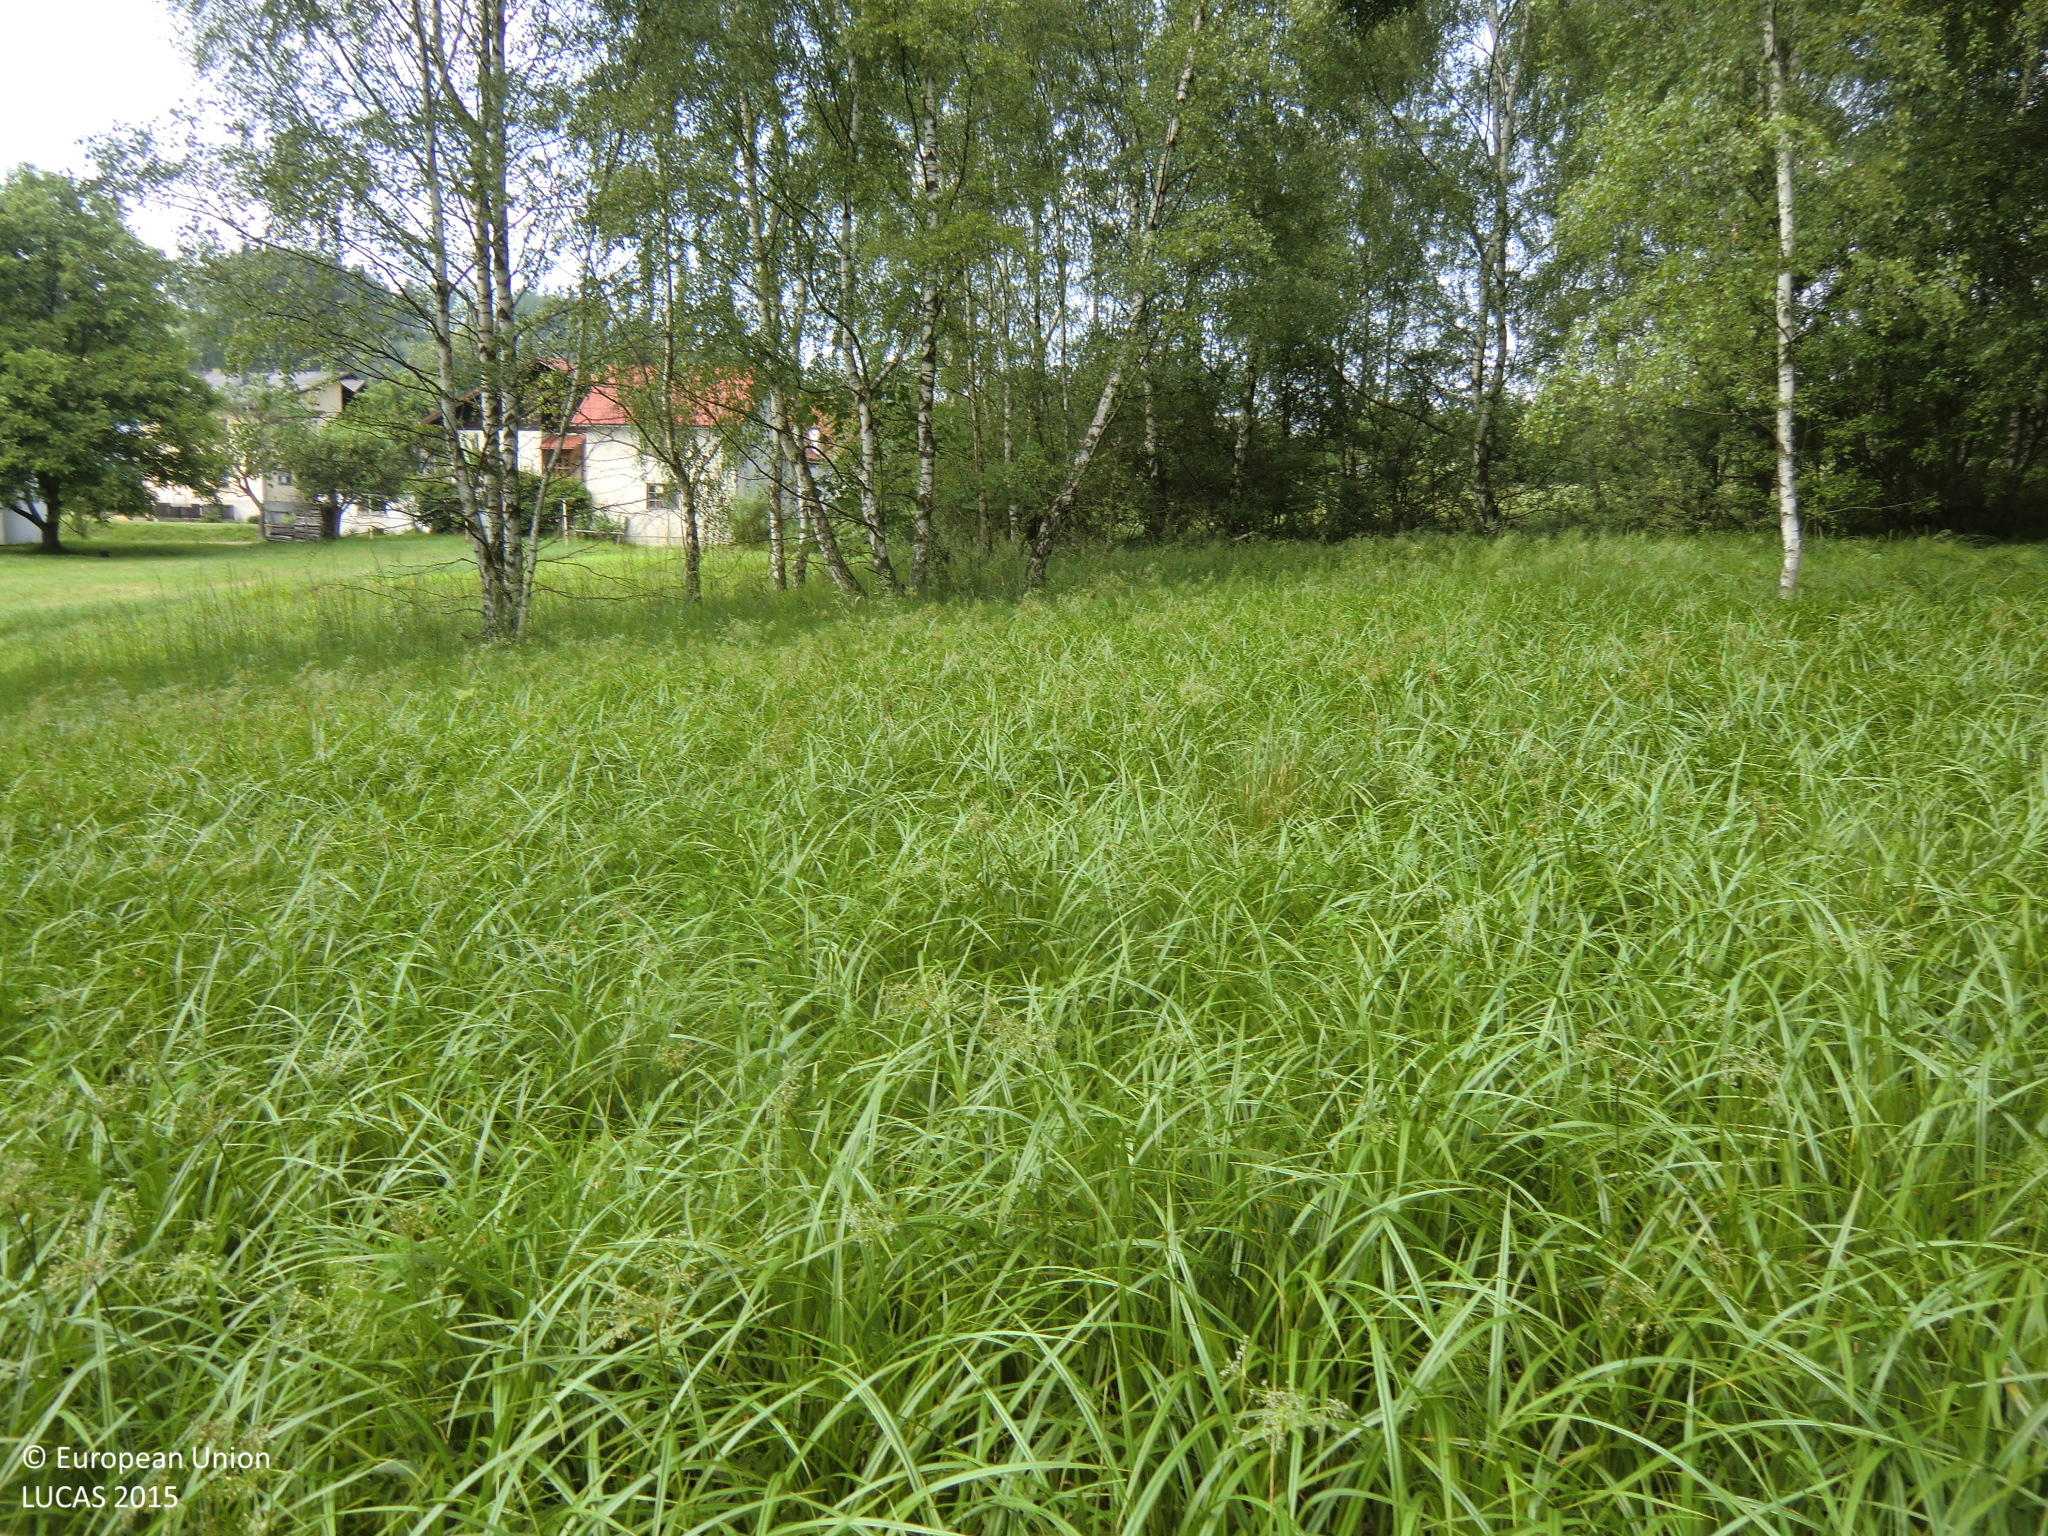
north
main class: Grassland
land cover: Spontaneously vegetated surfaces
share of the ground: > 75 %
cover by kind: herbaceous plants 100 %
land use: Abandoned areas
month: June
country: AT
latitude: 48.7139
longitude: 14.7991
